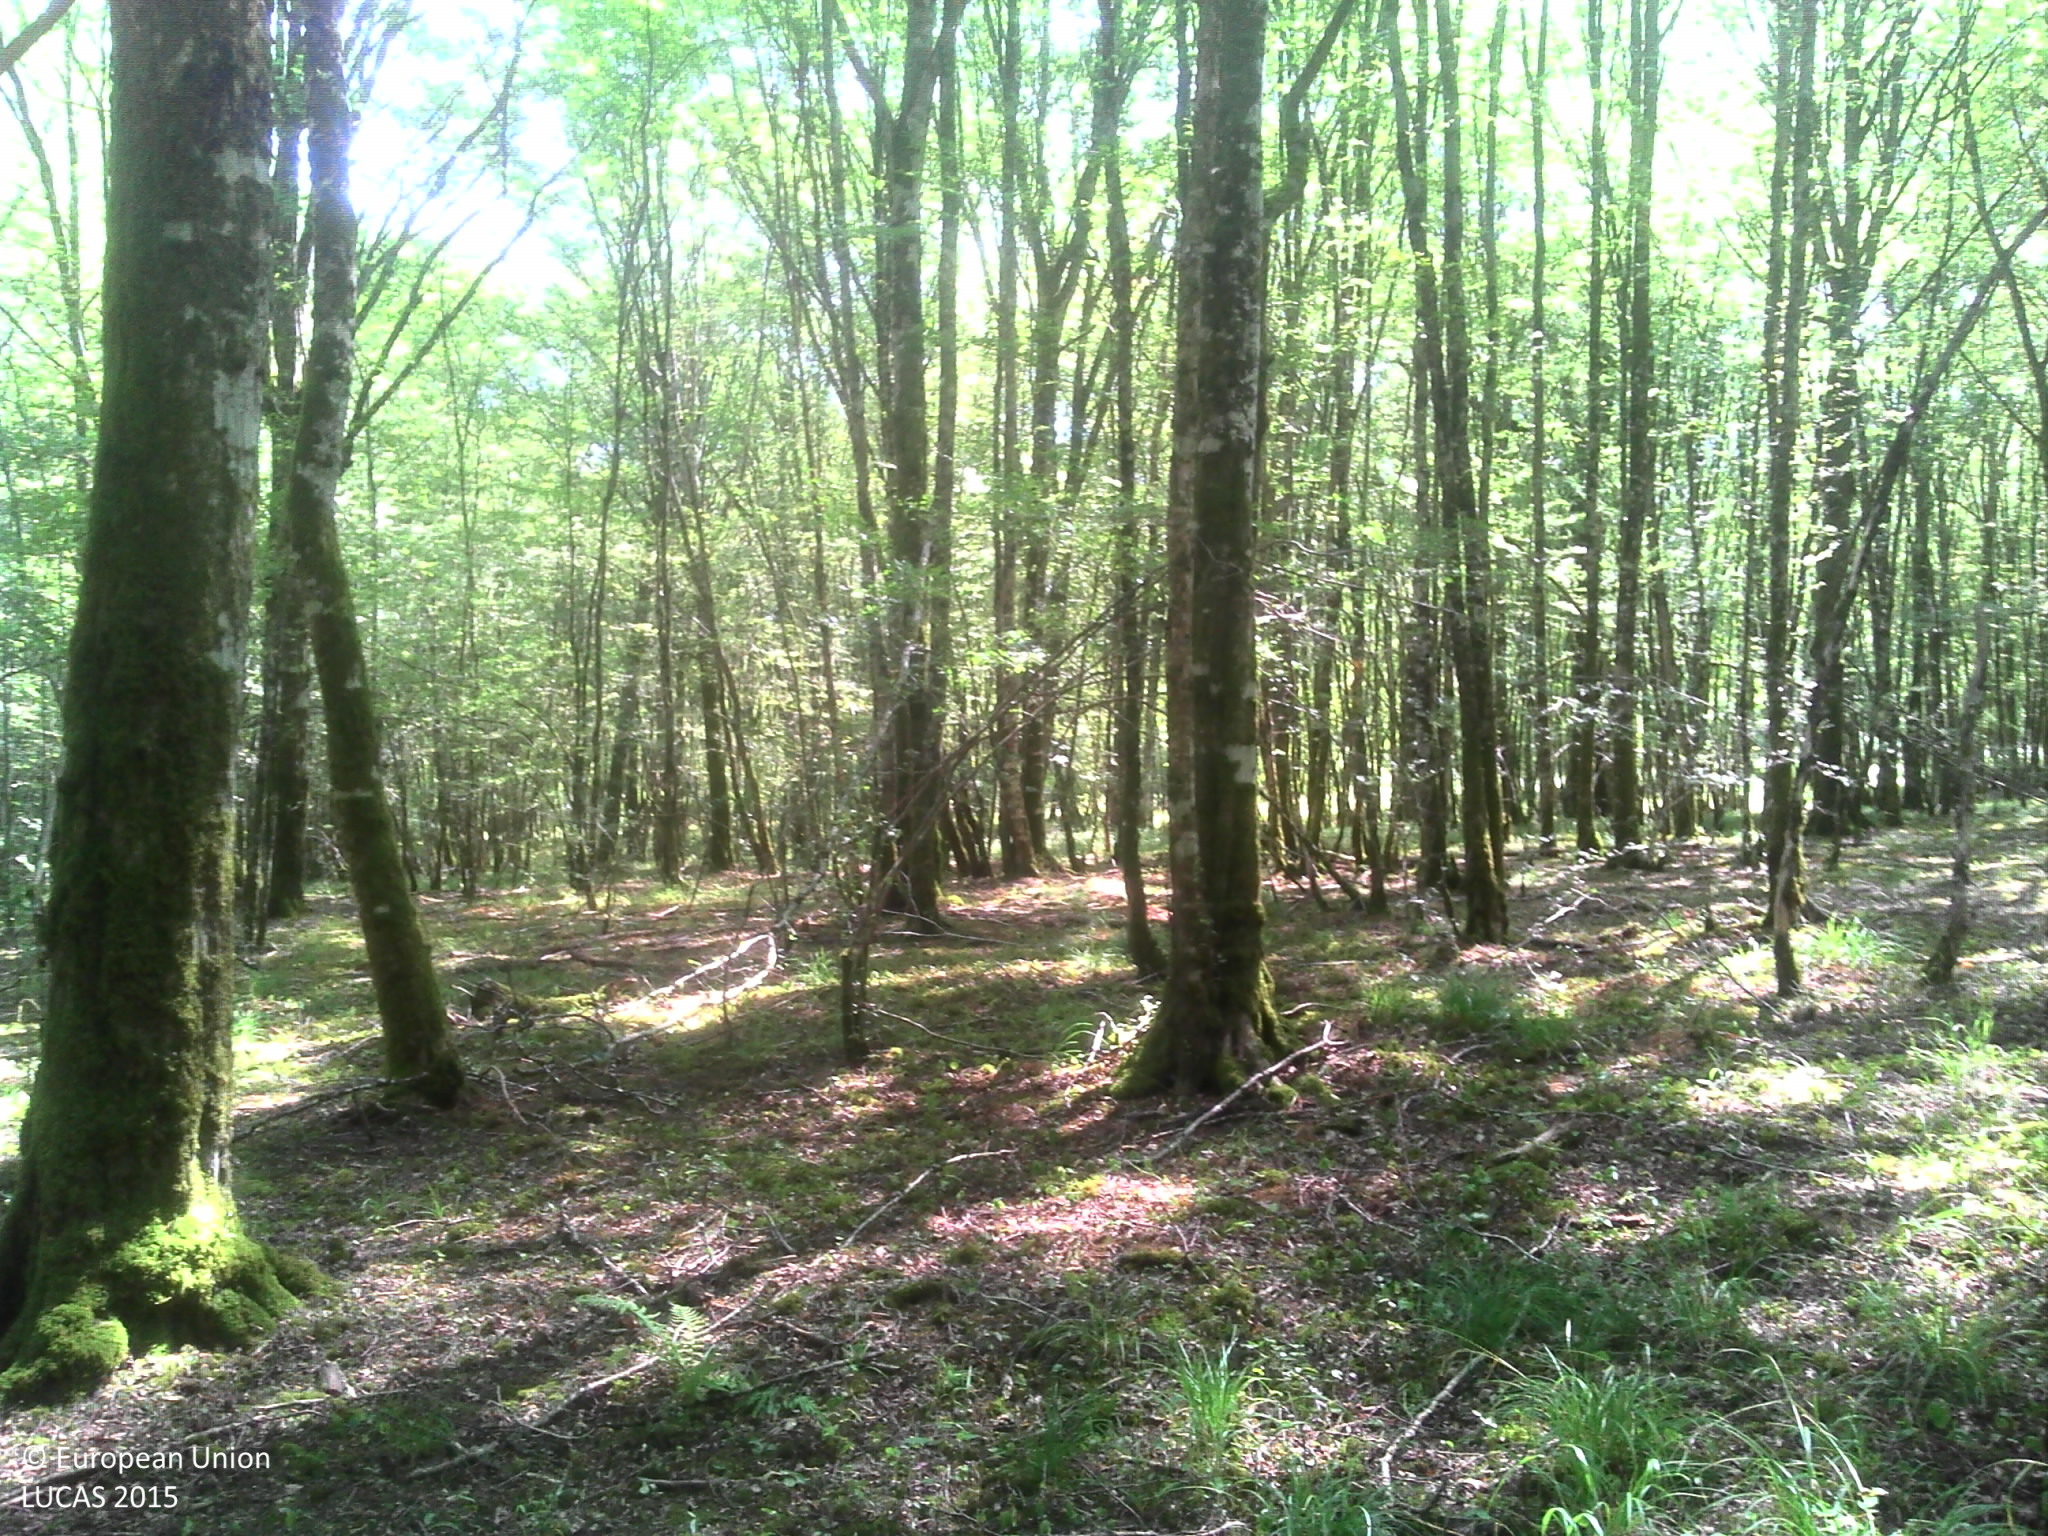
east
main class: Woodland
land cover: Broadleaved woodland
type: beech forest
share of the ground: > 75 %
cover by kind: broadleaved forest trees 80 %, herbaceous plants 10 %, lichens and mosses 10 %
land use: Forestry
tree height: > 5 m
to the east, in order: Broadleaved woodland; Tracks; Broadleaved woodland
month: July
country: FR
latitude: 48.0174
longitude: 4.9445
